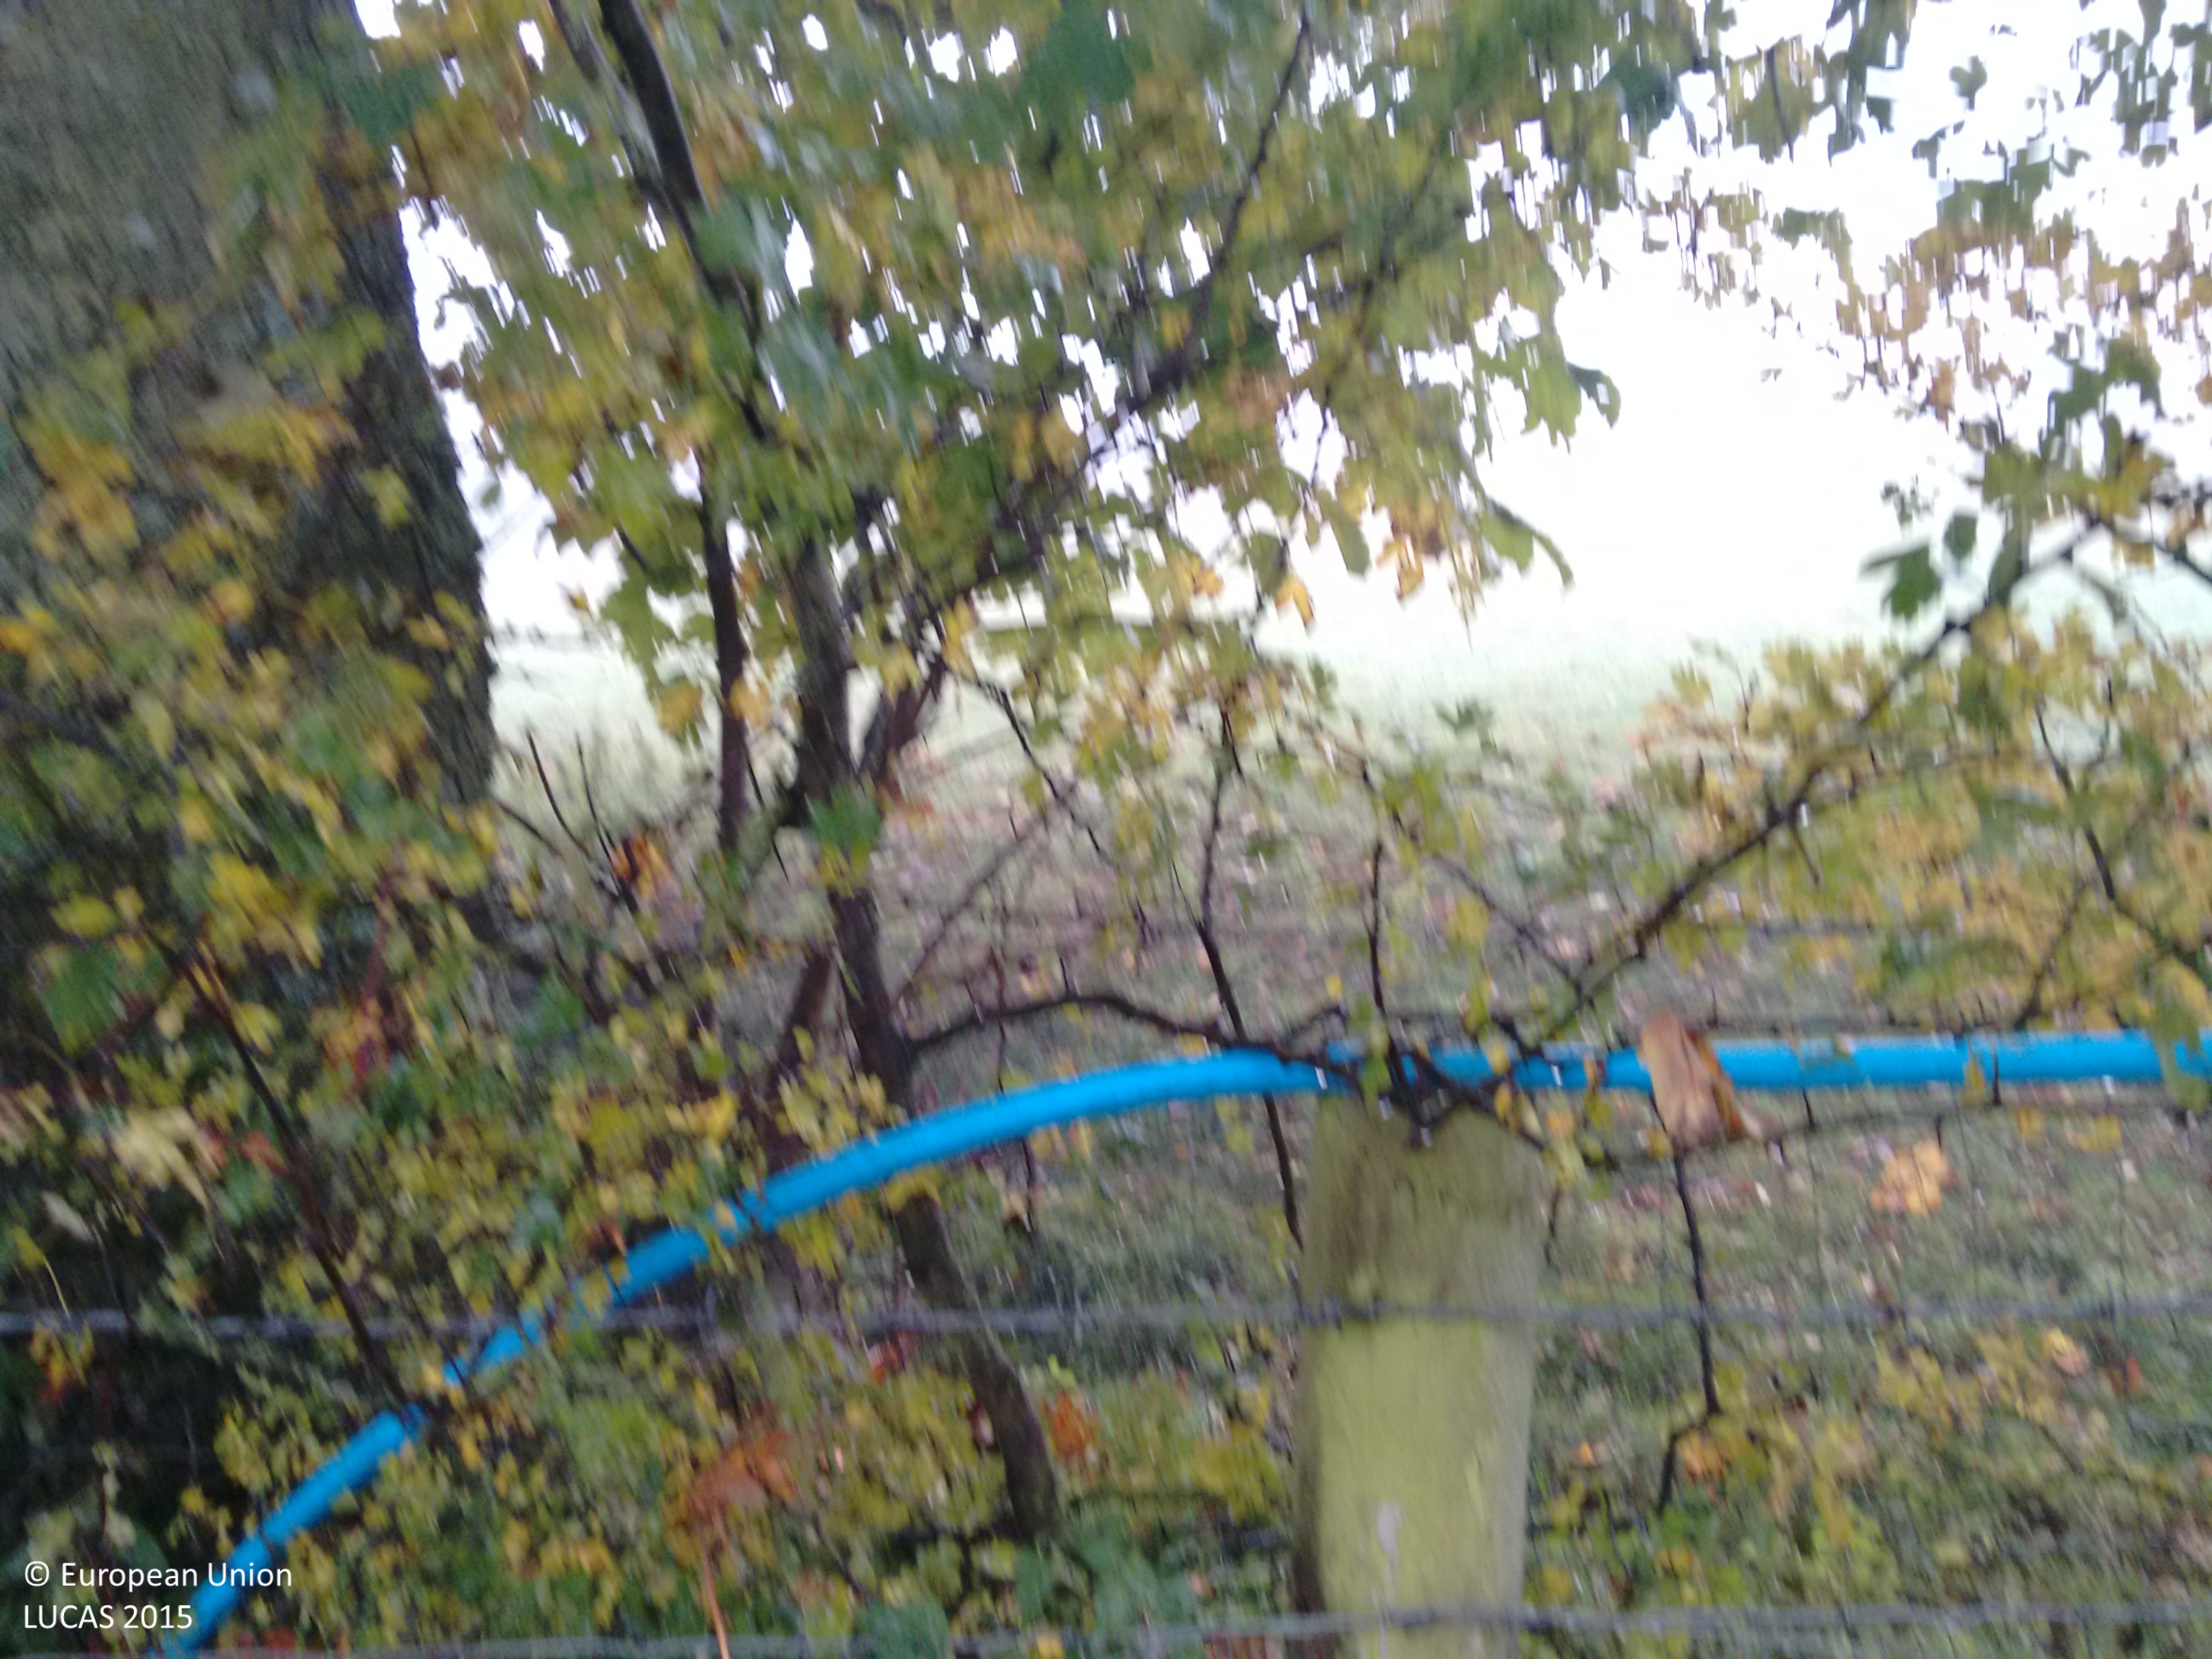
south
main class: Grassland
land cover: Grassland without tree/shrub cover
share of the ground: > 75 %
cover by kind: herbaceous plants 100 %
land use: Agriculture (excluding fallow land and kitchen gardens)
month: October
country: GB
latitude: 54.5187
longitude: -1.9346
